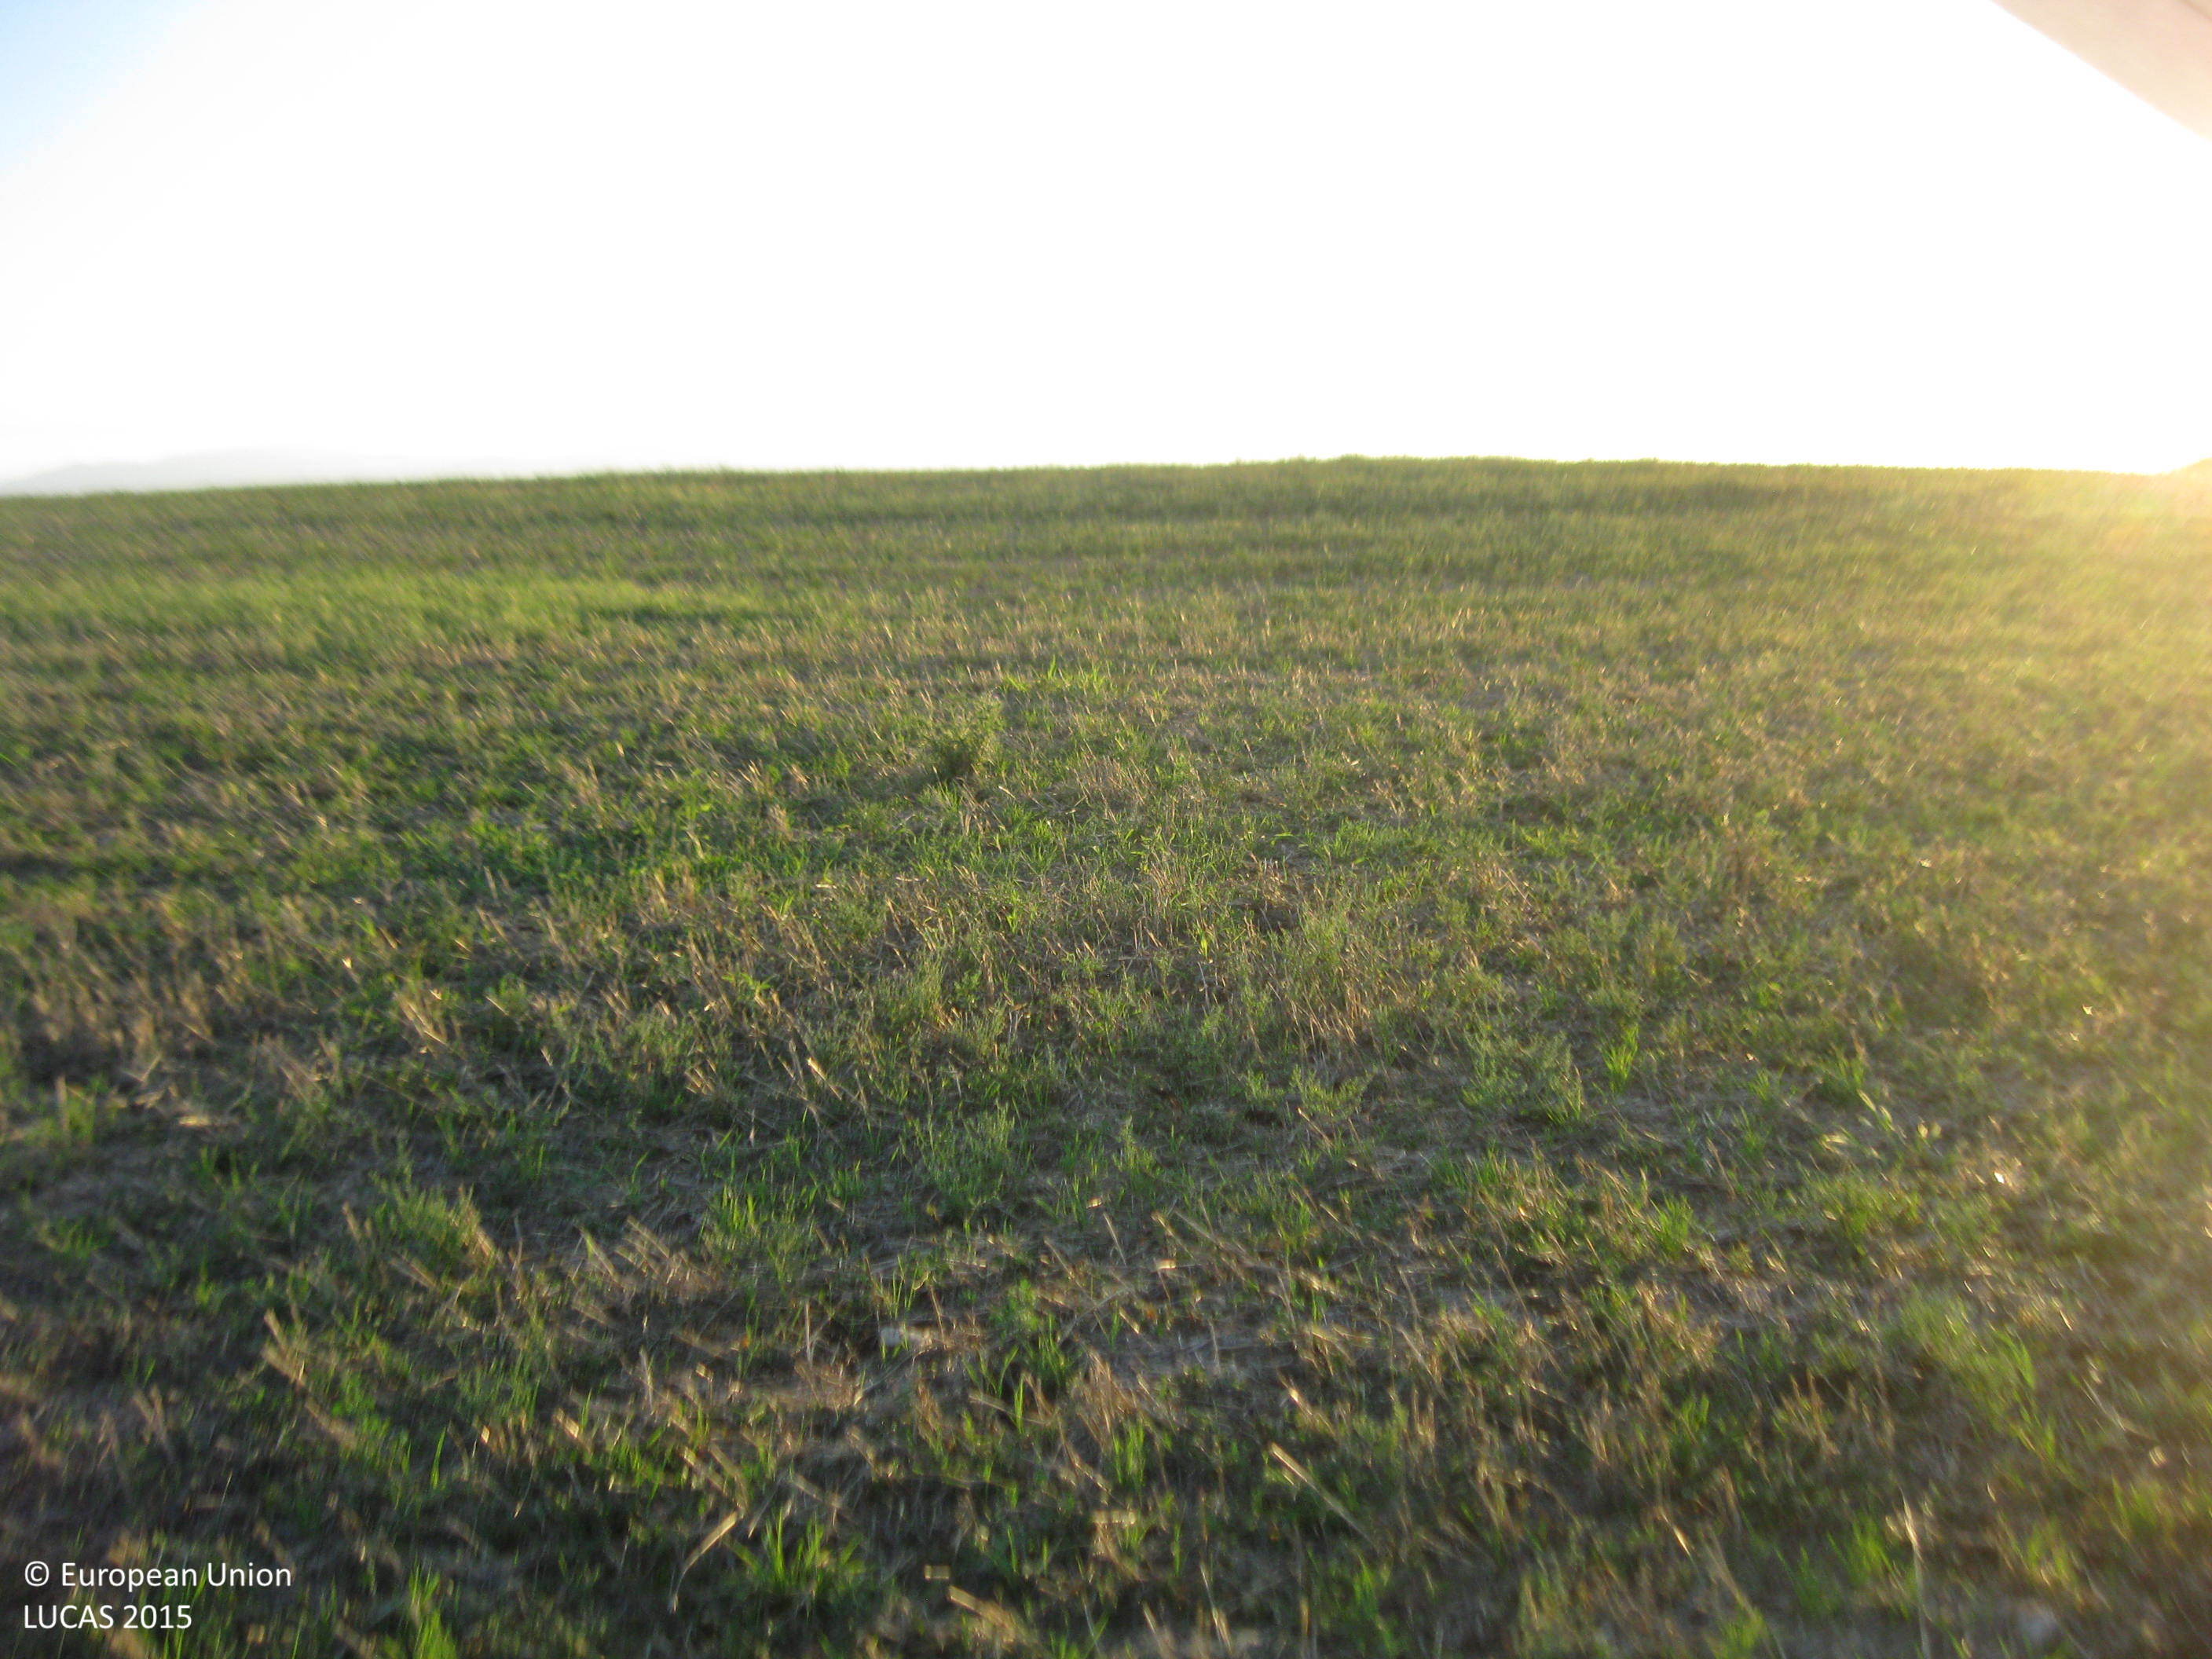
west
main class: Cropland
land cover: Common wheat
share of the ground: 25 - 50 %
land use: Agriculture (excluding fallow land and kitchen gardens)
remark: Harvested field
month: September
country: BG
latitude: 42.0963
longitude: 25.0123
